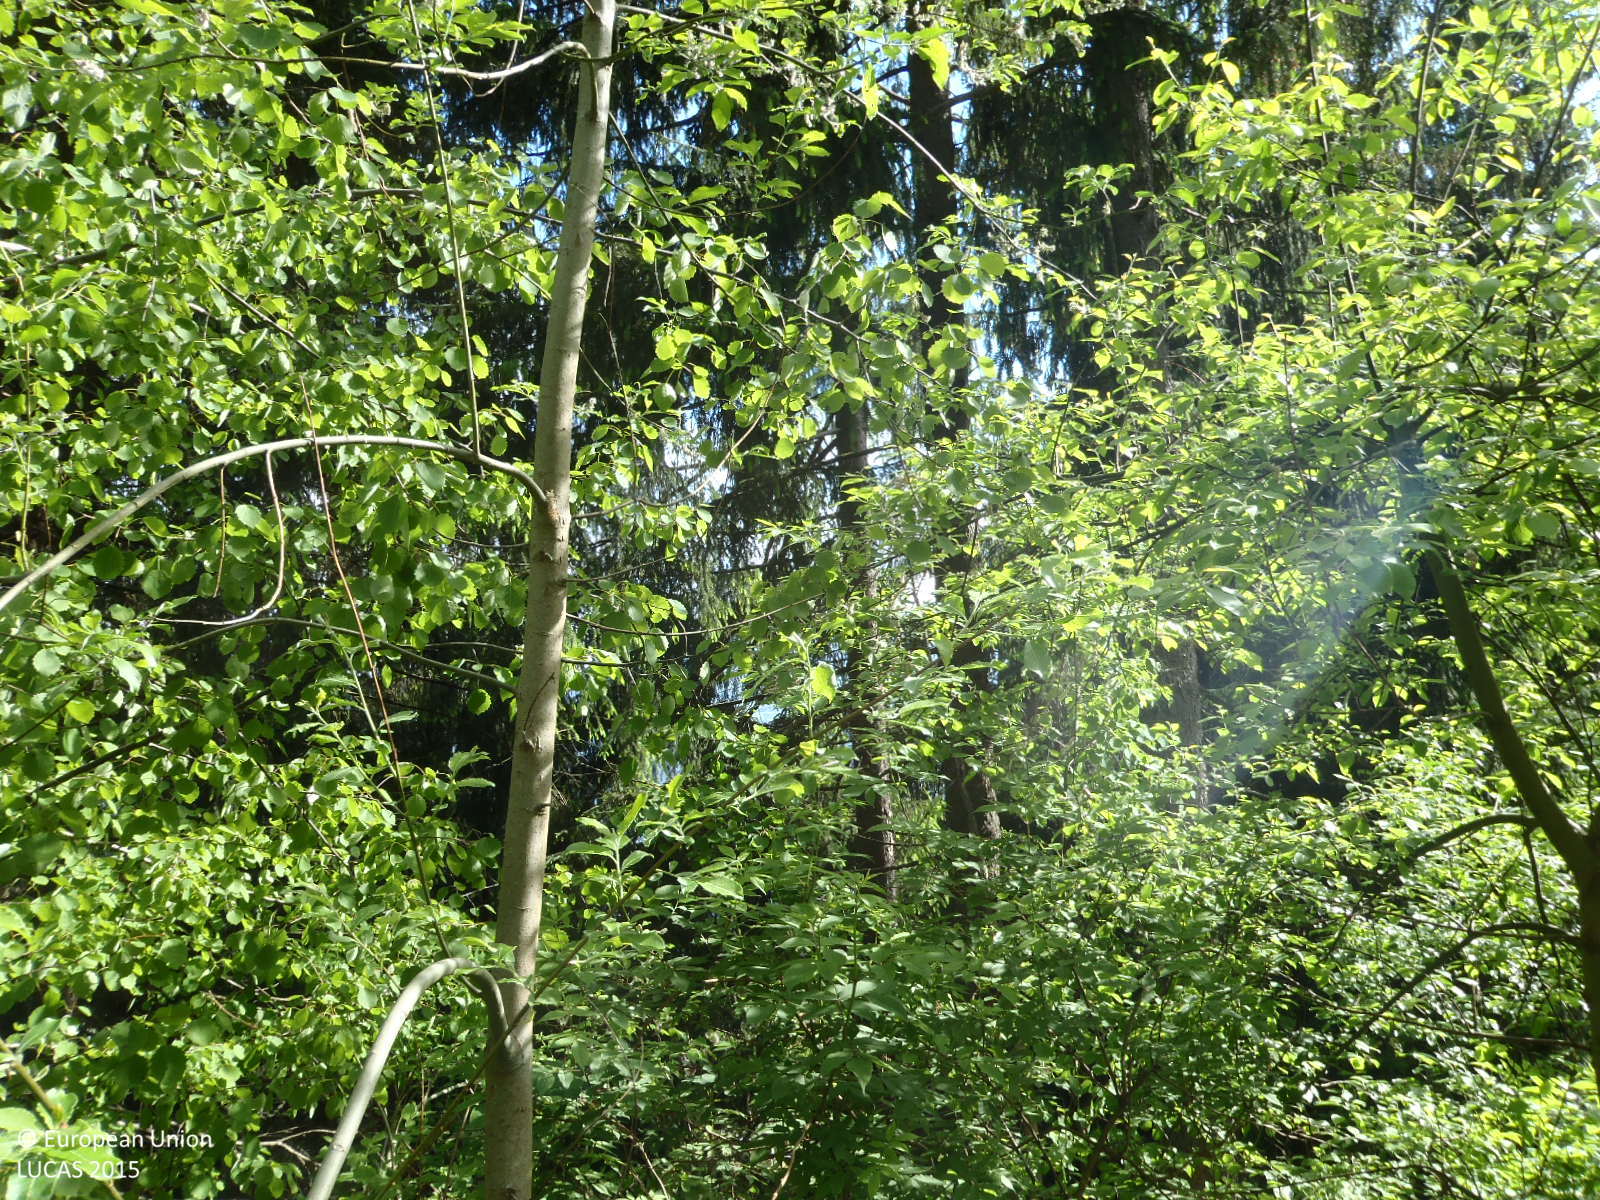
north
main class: Woodland
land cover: Spruce dominated mixed woodland
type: alpine coniferous forest
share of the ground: > 75 %
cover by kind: coniferous forest trees 65 %, broadleaved forest trees 25 %, shrubs 10 %
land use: Forestry
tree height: > 5 m
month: May
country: AT
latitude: 47.2632
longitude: 11.1751
